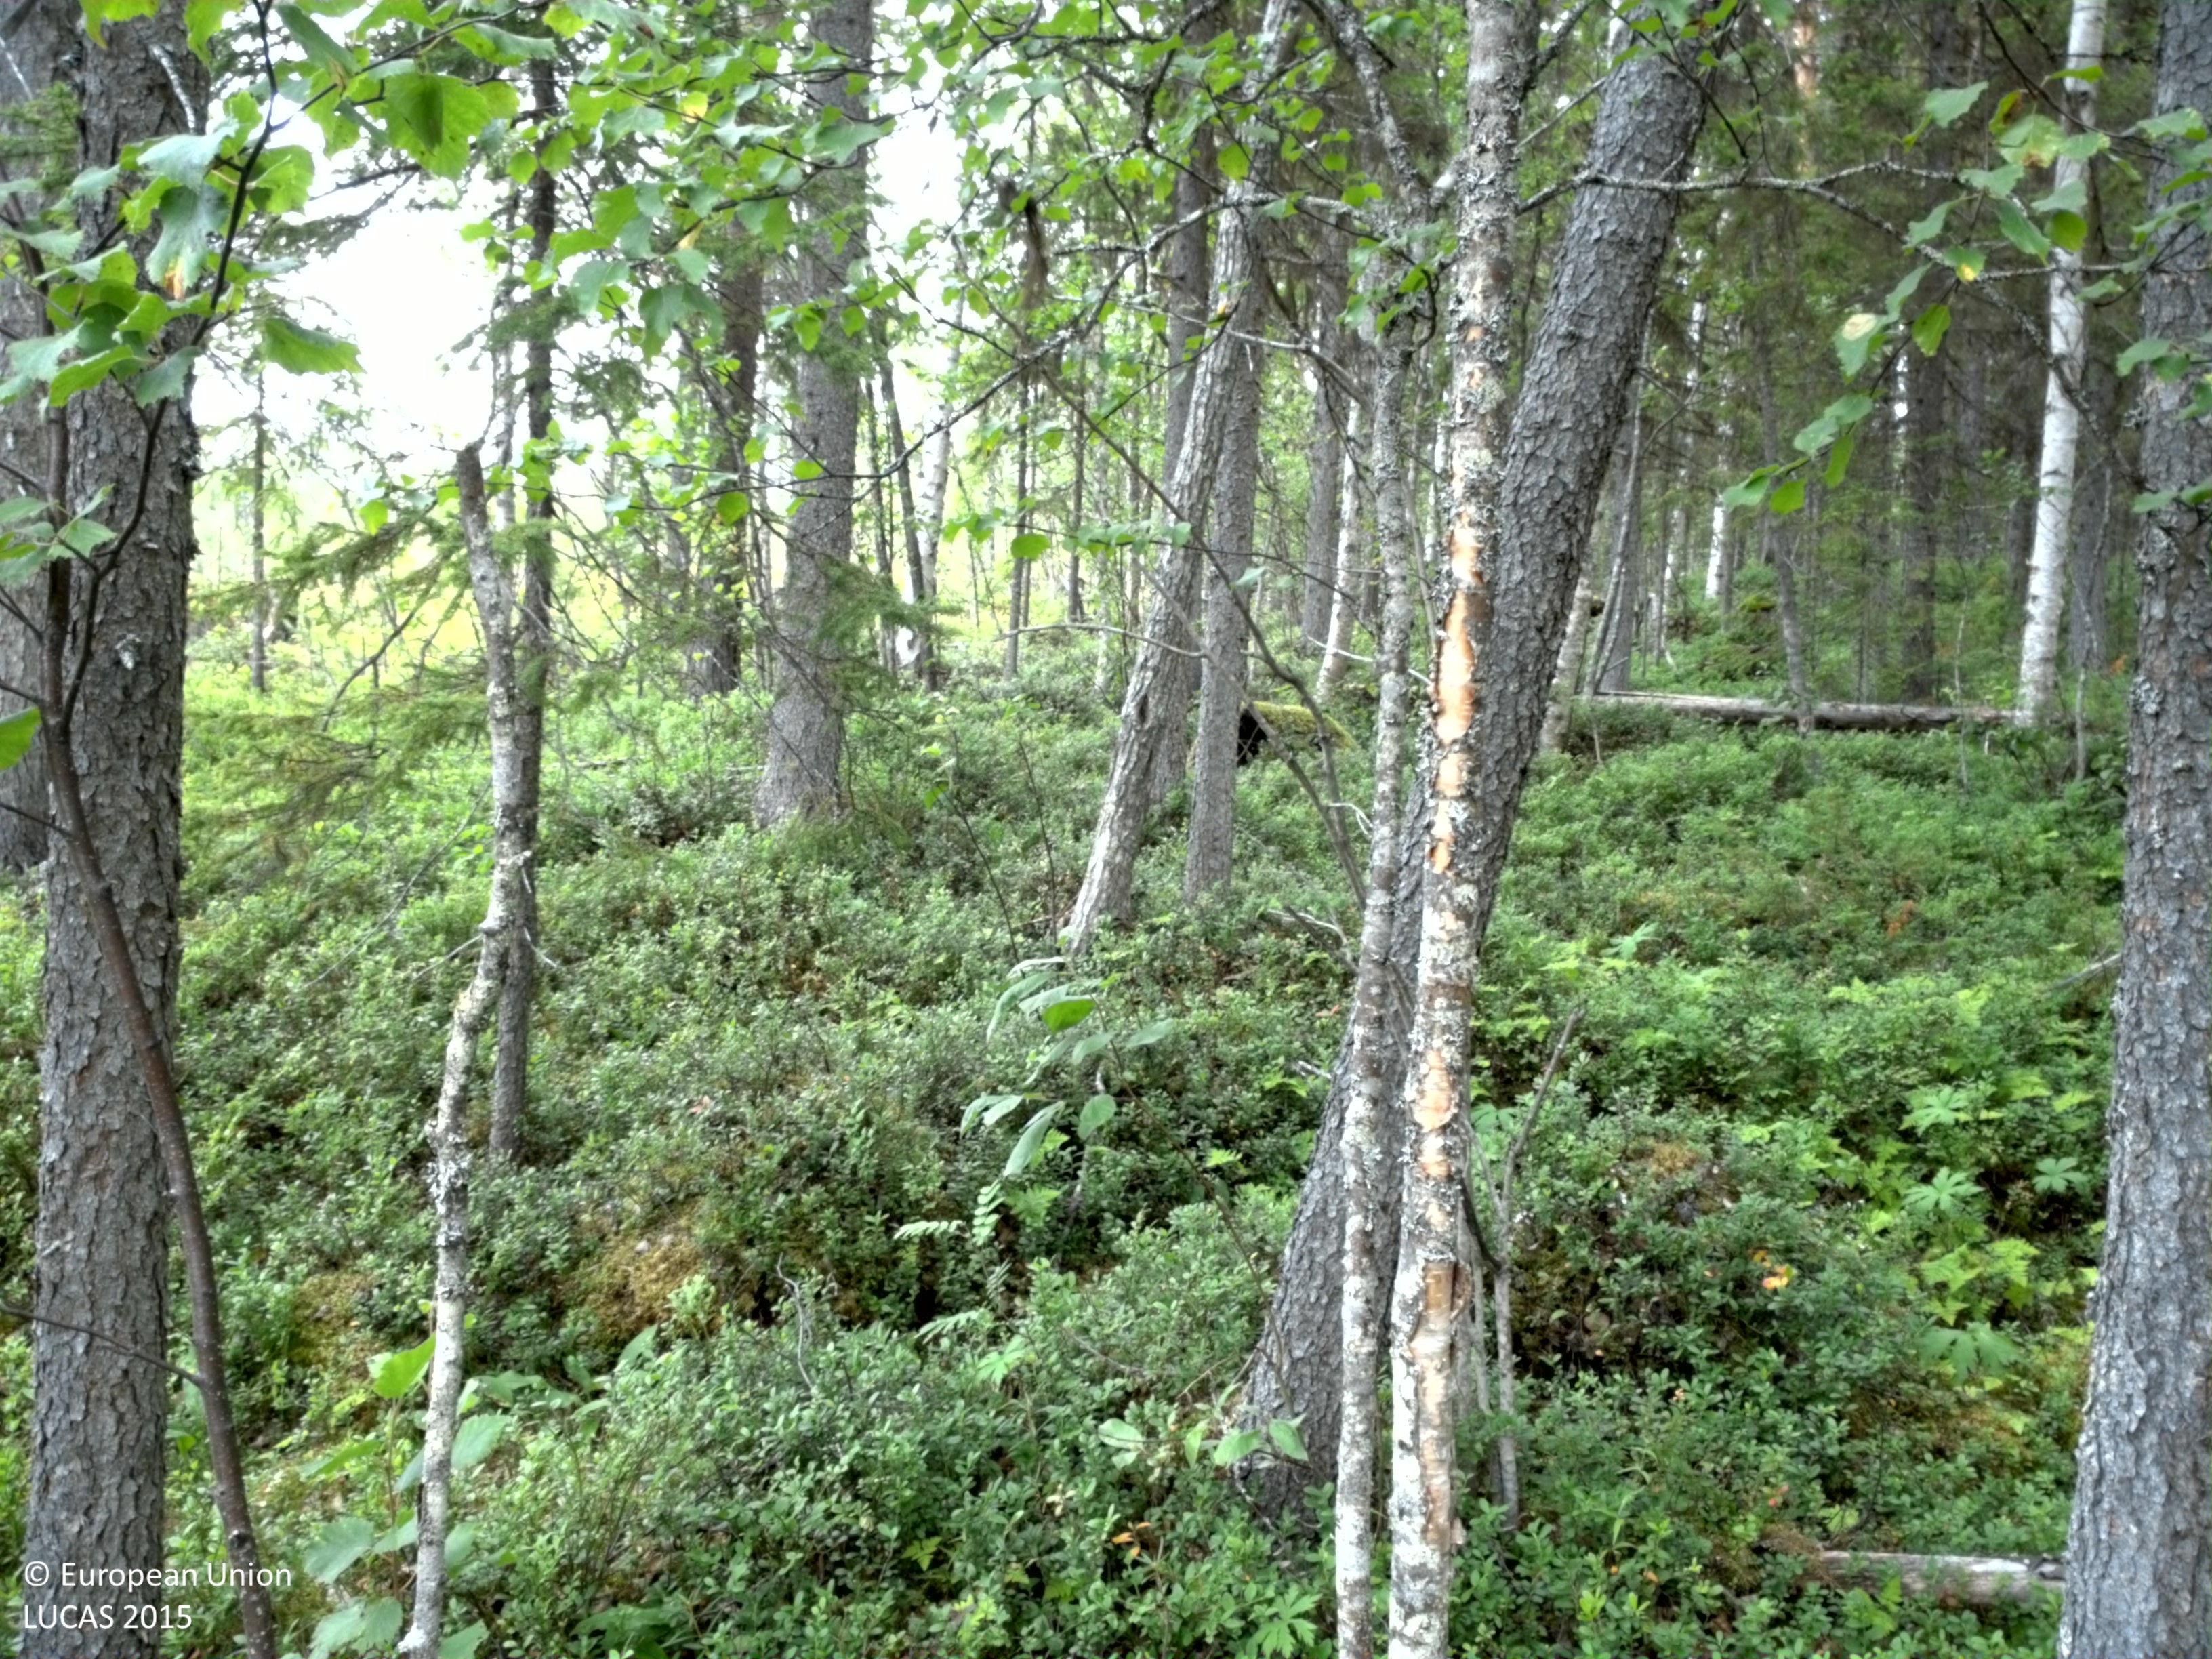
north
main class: Woodland
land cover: Spruce dominated mixed woodland
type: boreal forest
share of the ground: 50 - 75 %
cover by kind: shrubs 40 %, coniferous forest trees 35 %, broadleaved forest trees 25 %
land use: Forestry
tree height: > 5 m
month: August
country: SE
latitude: 66.2986
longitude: 20.4588
